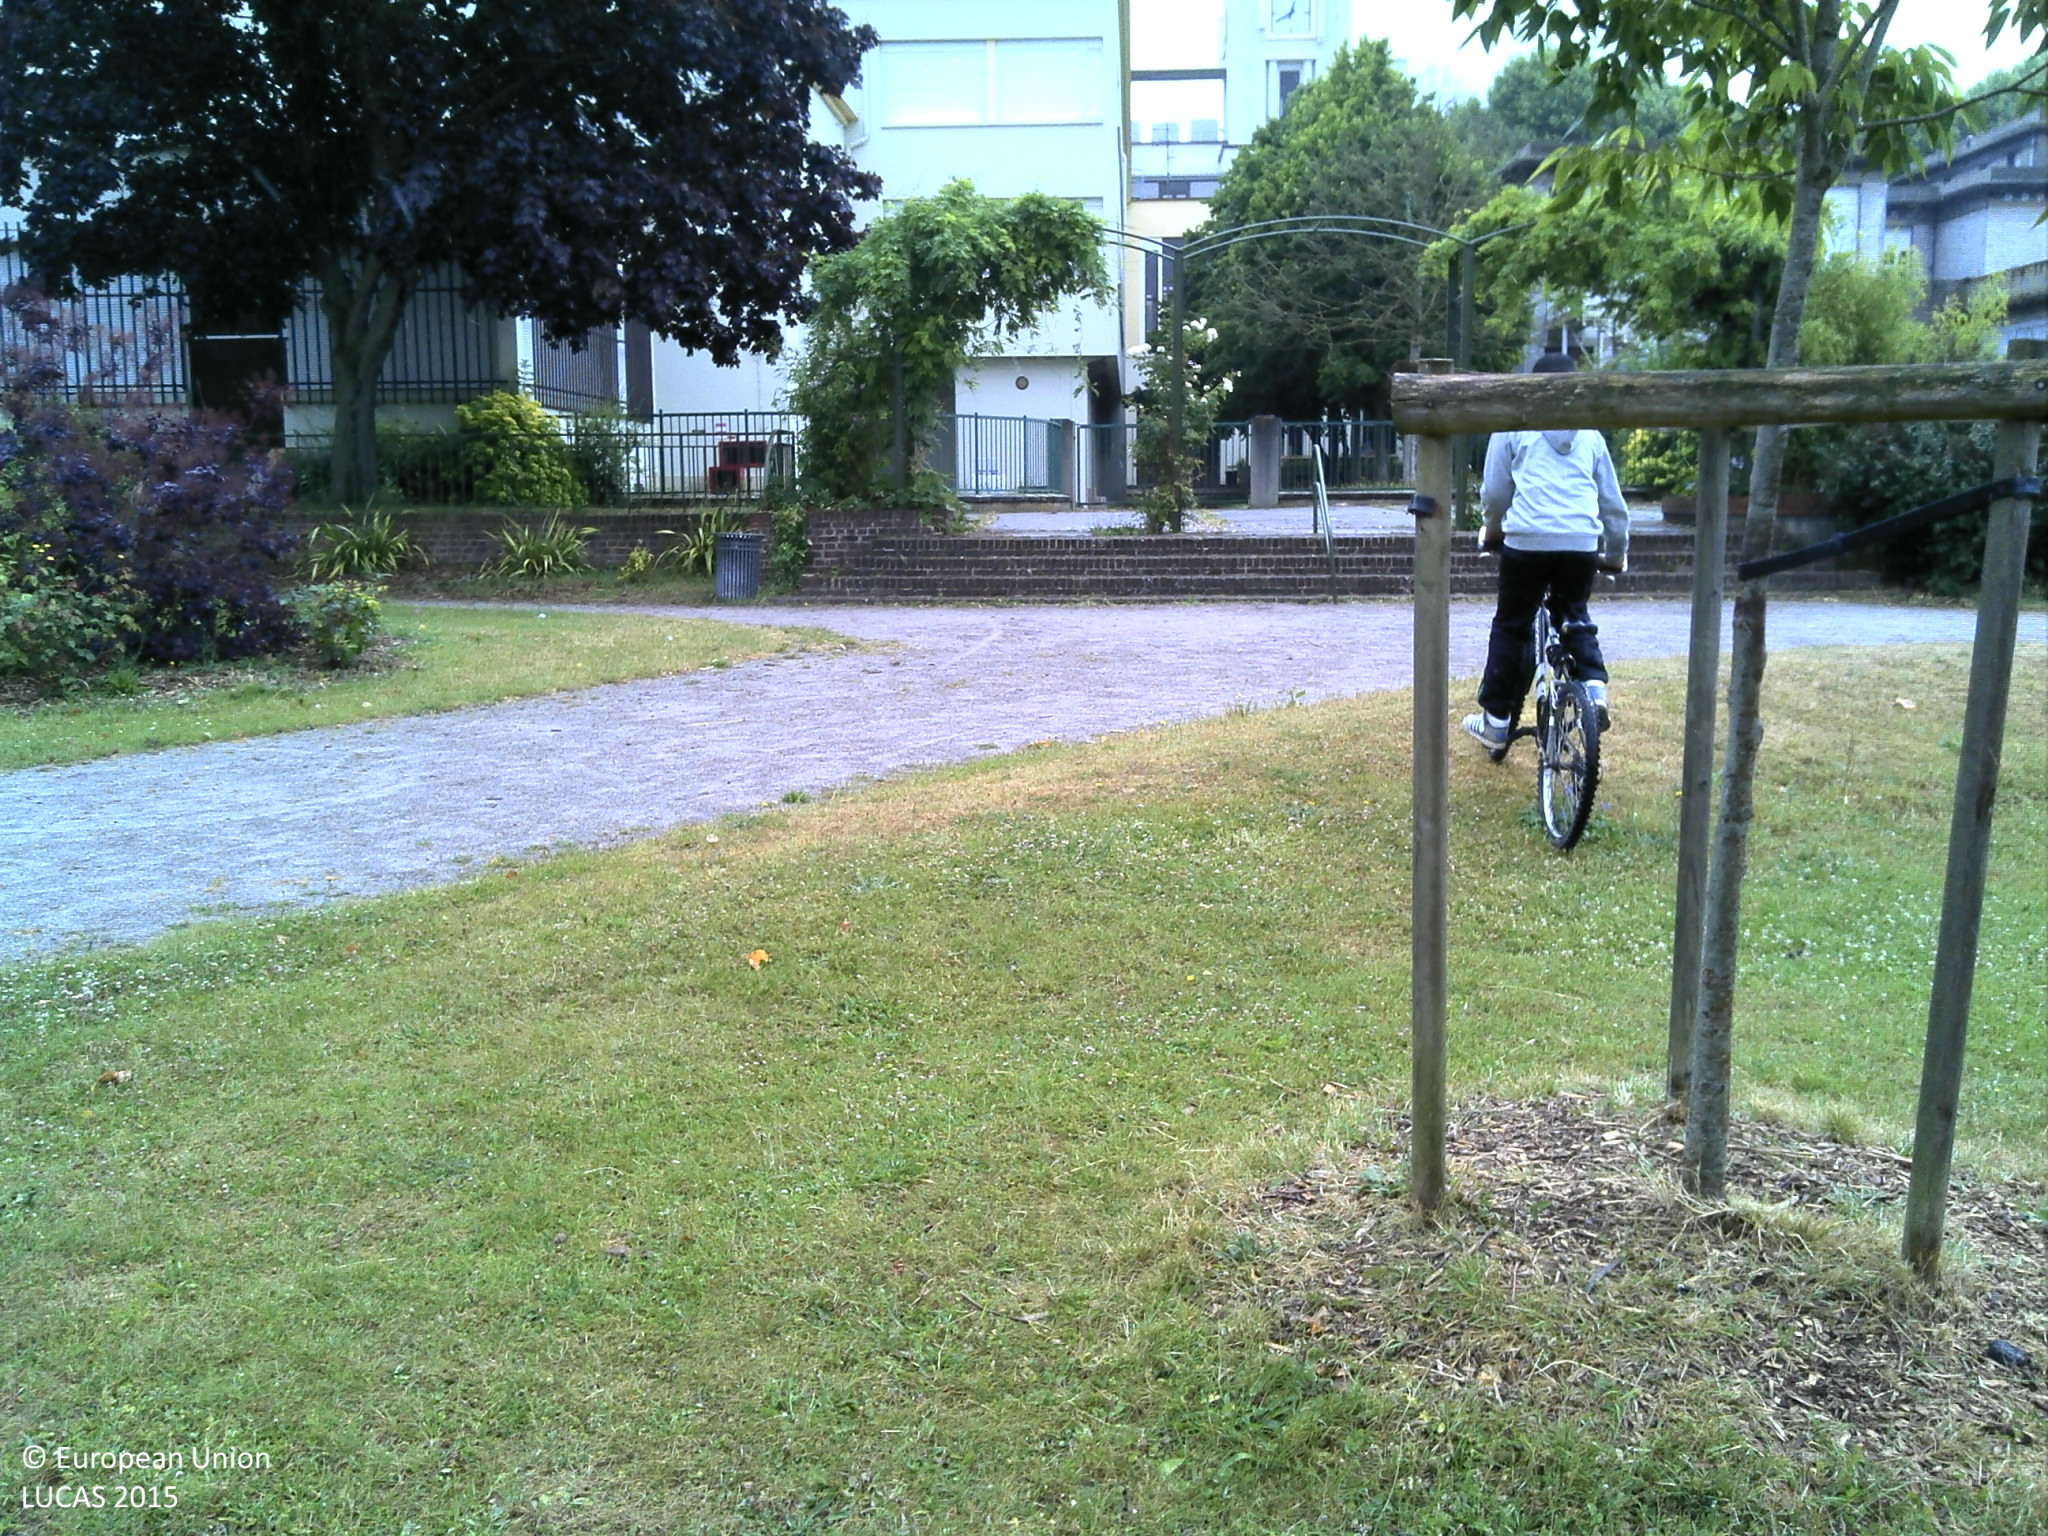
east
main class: Grassland
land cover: Grassland with sparse tree/shrub cover
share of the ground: > 75 %
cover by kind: herbaceous plants 95 %, broadleaved forest trees 5 %
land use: Amenities, museums, leisure
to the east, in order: Grassland with sparse tree/shrub cover; Artificial constructions in urban areas
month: June
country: FR
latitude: 49.4141
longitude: 1.0324
